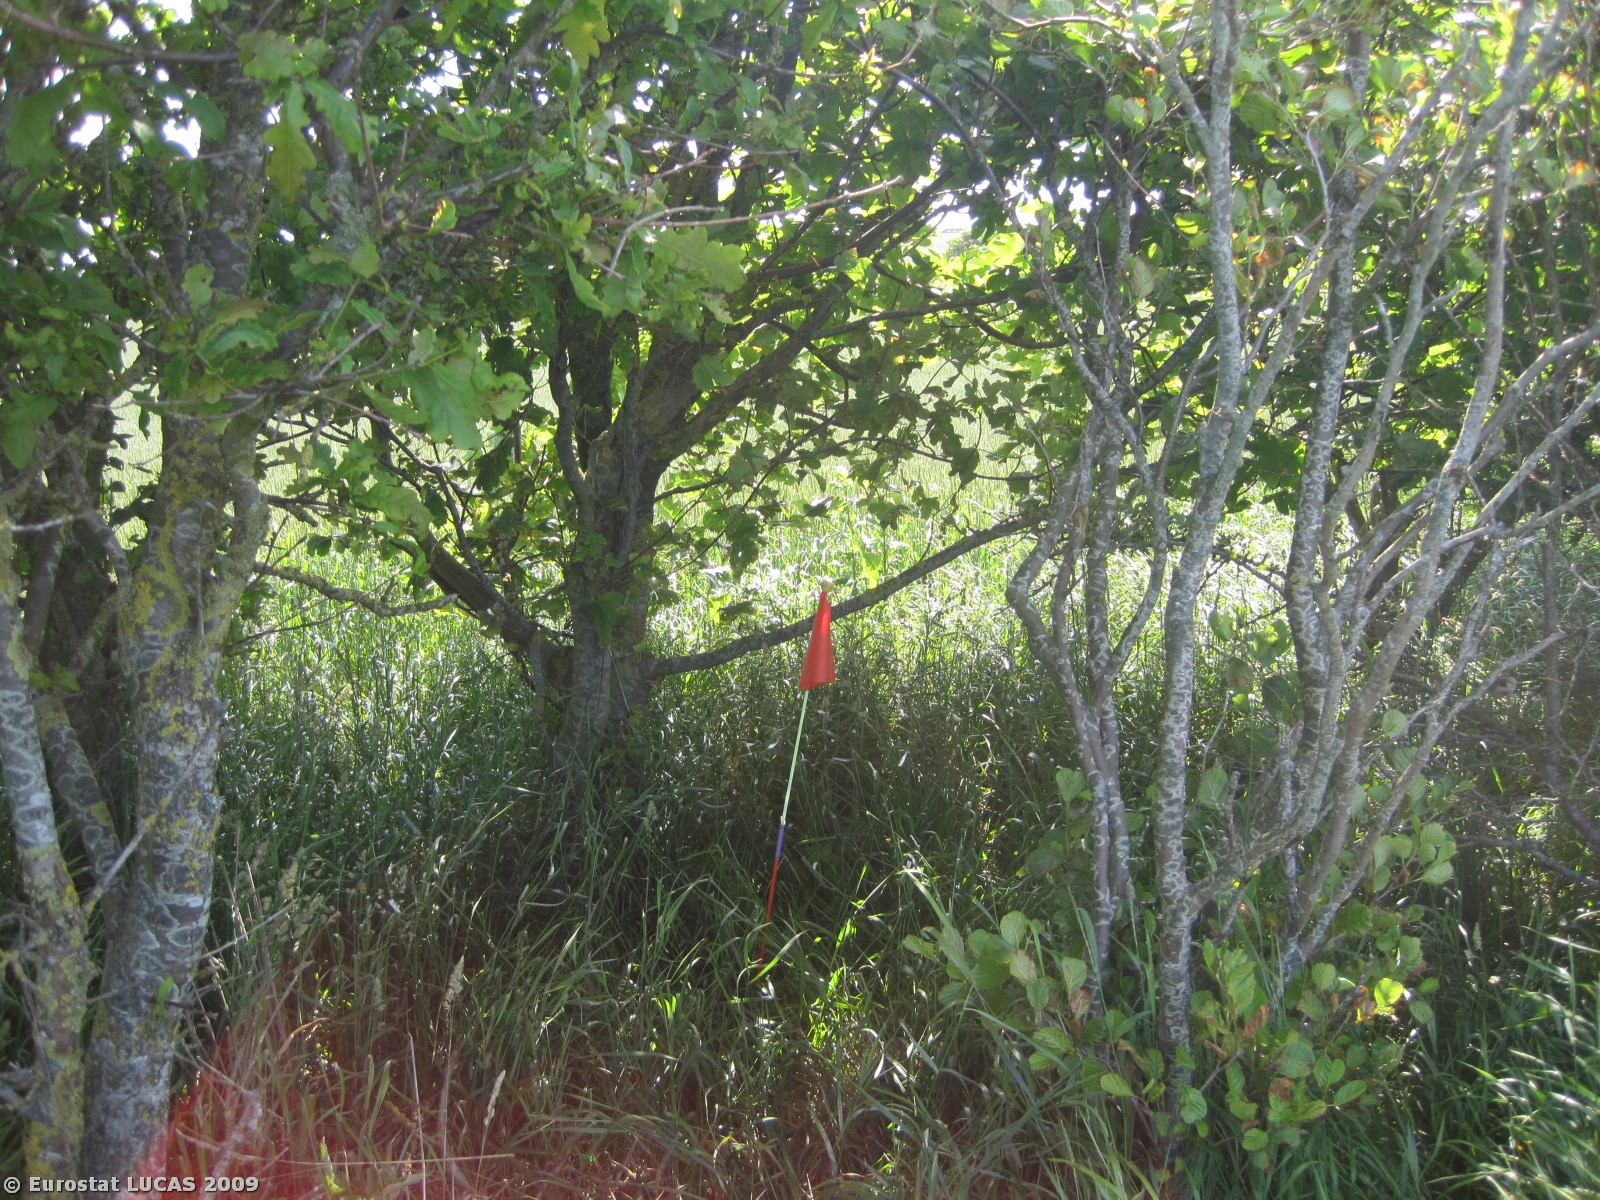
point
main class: Woodland
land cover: Broadleaved woodland
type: plantations and self-sown exotic forest
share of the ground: > 75 %
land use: Unused
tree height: > 5 m
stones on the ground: < 10 %
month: June
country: DK
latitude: 56.9043
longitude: 9.1966
